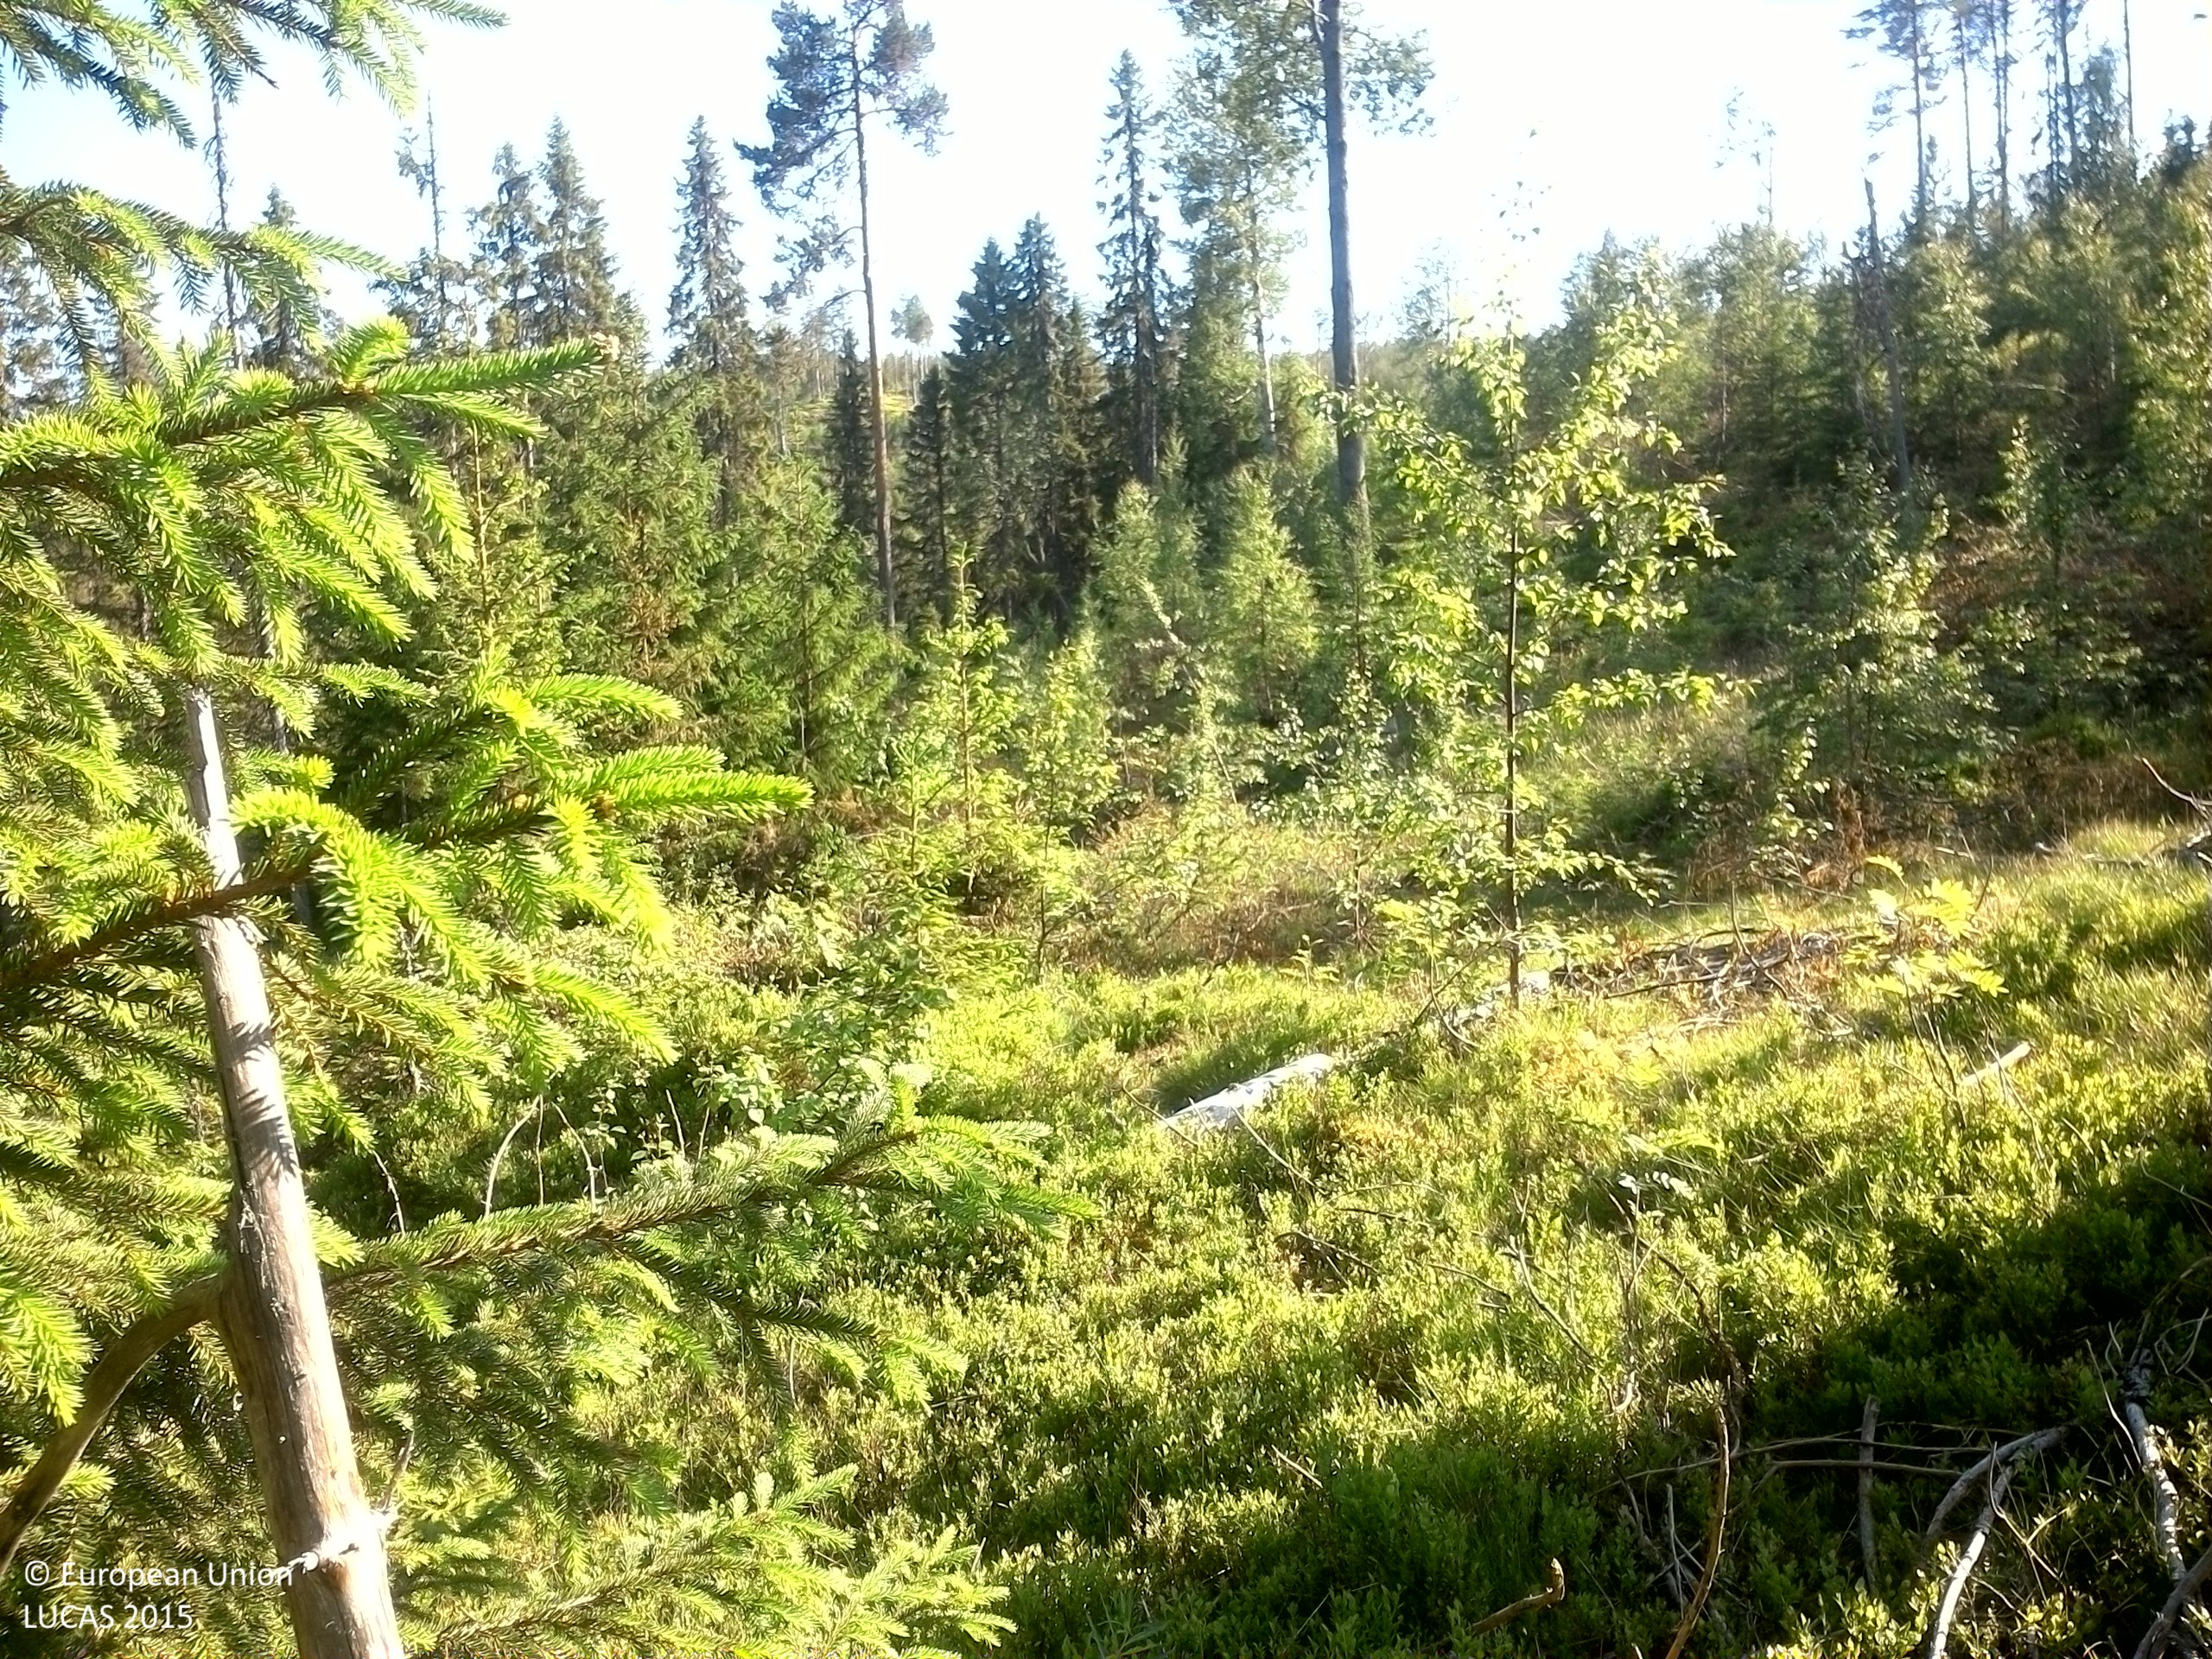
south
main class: Woodland
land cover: Spruce dominated mixed woodland
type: boreal forest
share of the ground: 25 - 50 %
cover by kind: shrubs 60 %, coniferous forest trees 30 %, broadleaved forest trees 10 %
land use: Forestry
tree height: < 5 m
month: July
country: SE
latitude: 62.7980
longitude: 17.2920
